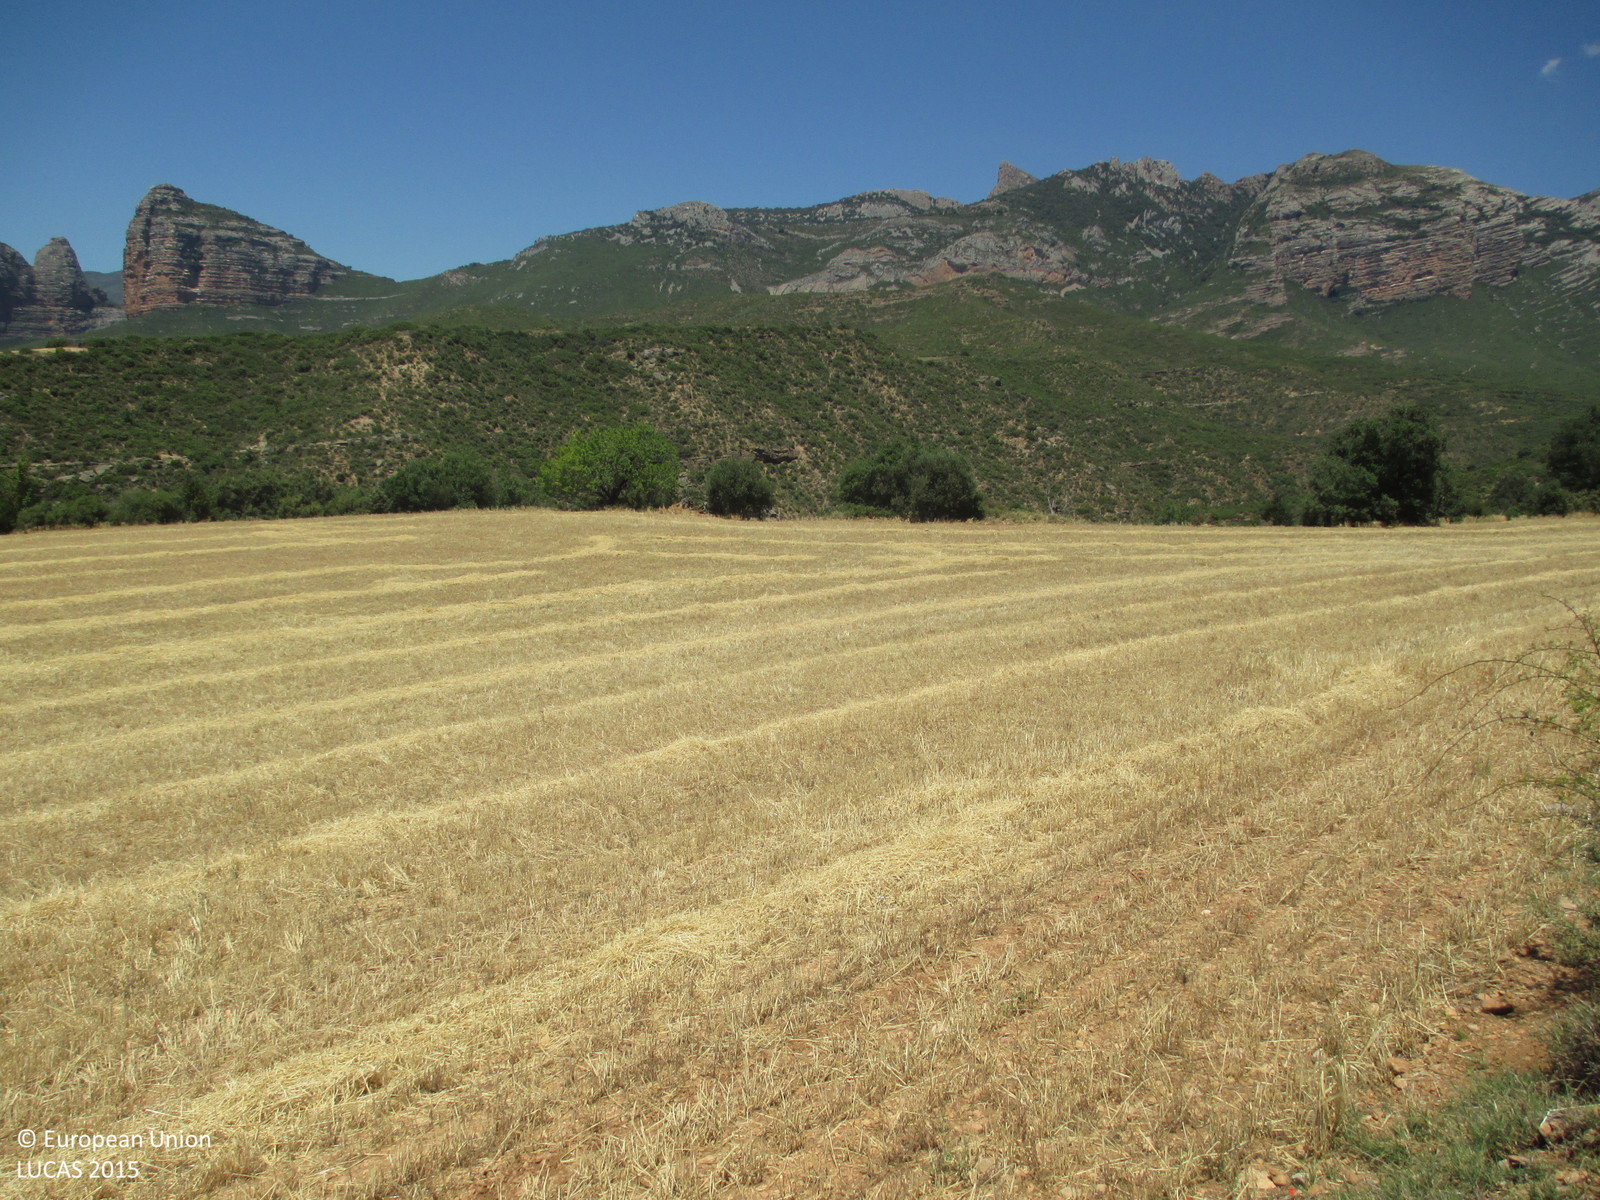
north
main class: Shrubland
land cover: Shrubland with sparse tree cover
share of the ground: > 75 %
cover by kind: shrubs 90 %, broadleaved forest trees 5 %, herbaceous plants 5 %
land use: Semi-natural and natural areas not in use
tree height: < 5 m
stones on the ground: < 10 %
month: June
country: ES
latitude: 42.2307
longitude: -0.3585
